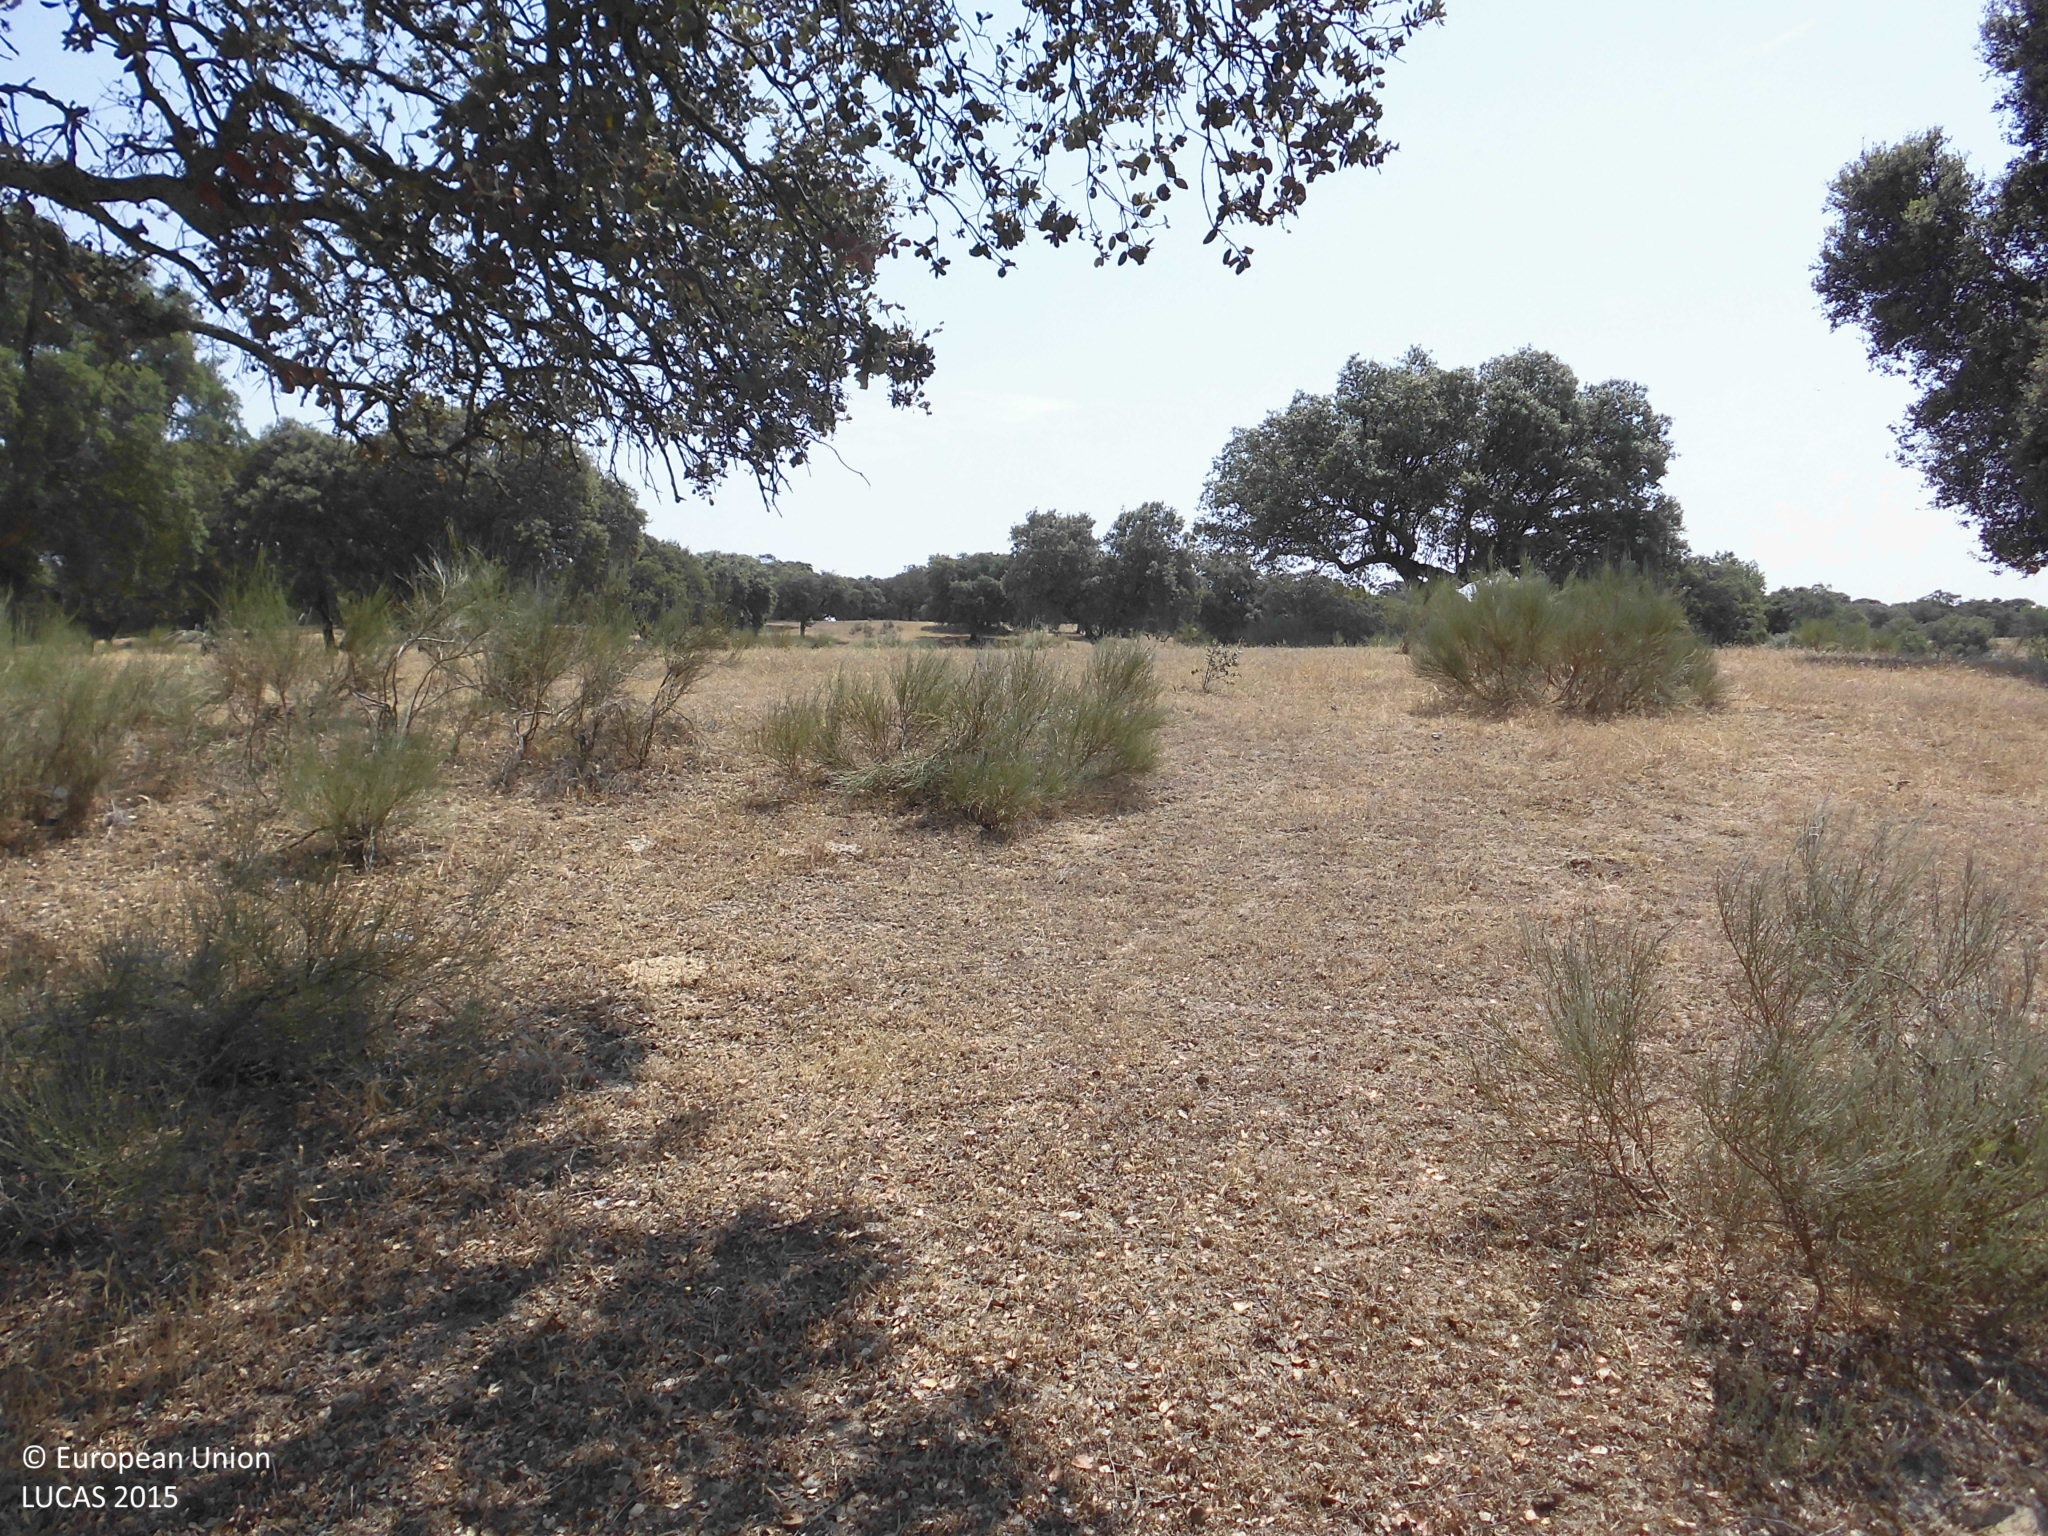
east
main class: Woodland
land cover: Broadleaved woodland
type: broadleaved evergreen forest
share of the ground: 10 - 25 %
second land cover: Grassland without tree/shrub cover
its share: > 75 %
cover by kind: herbaceous plants 80 %, broadleaved forest trees 15 %, consolidated bare surface 5 %
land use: Forestry
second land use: Agriculture (excluding fallow land and kitchen gardens)
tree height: > 5 m
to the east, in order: Broadleaved woodland; Grassland without tree/shrub cover; Broadleaved woodland
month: June
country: ES
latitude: 39.9032
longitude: -5.6529
